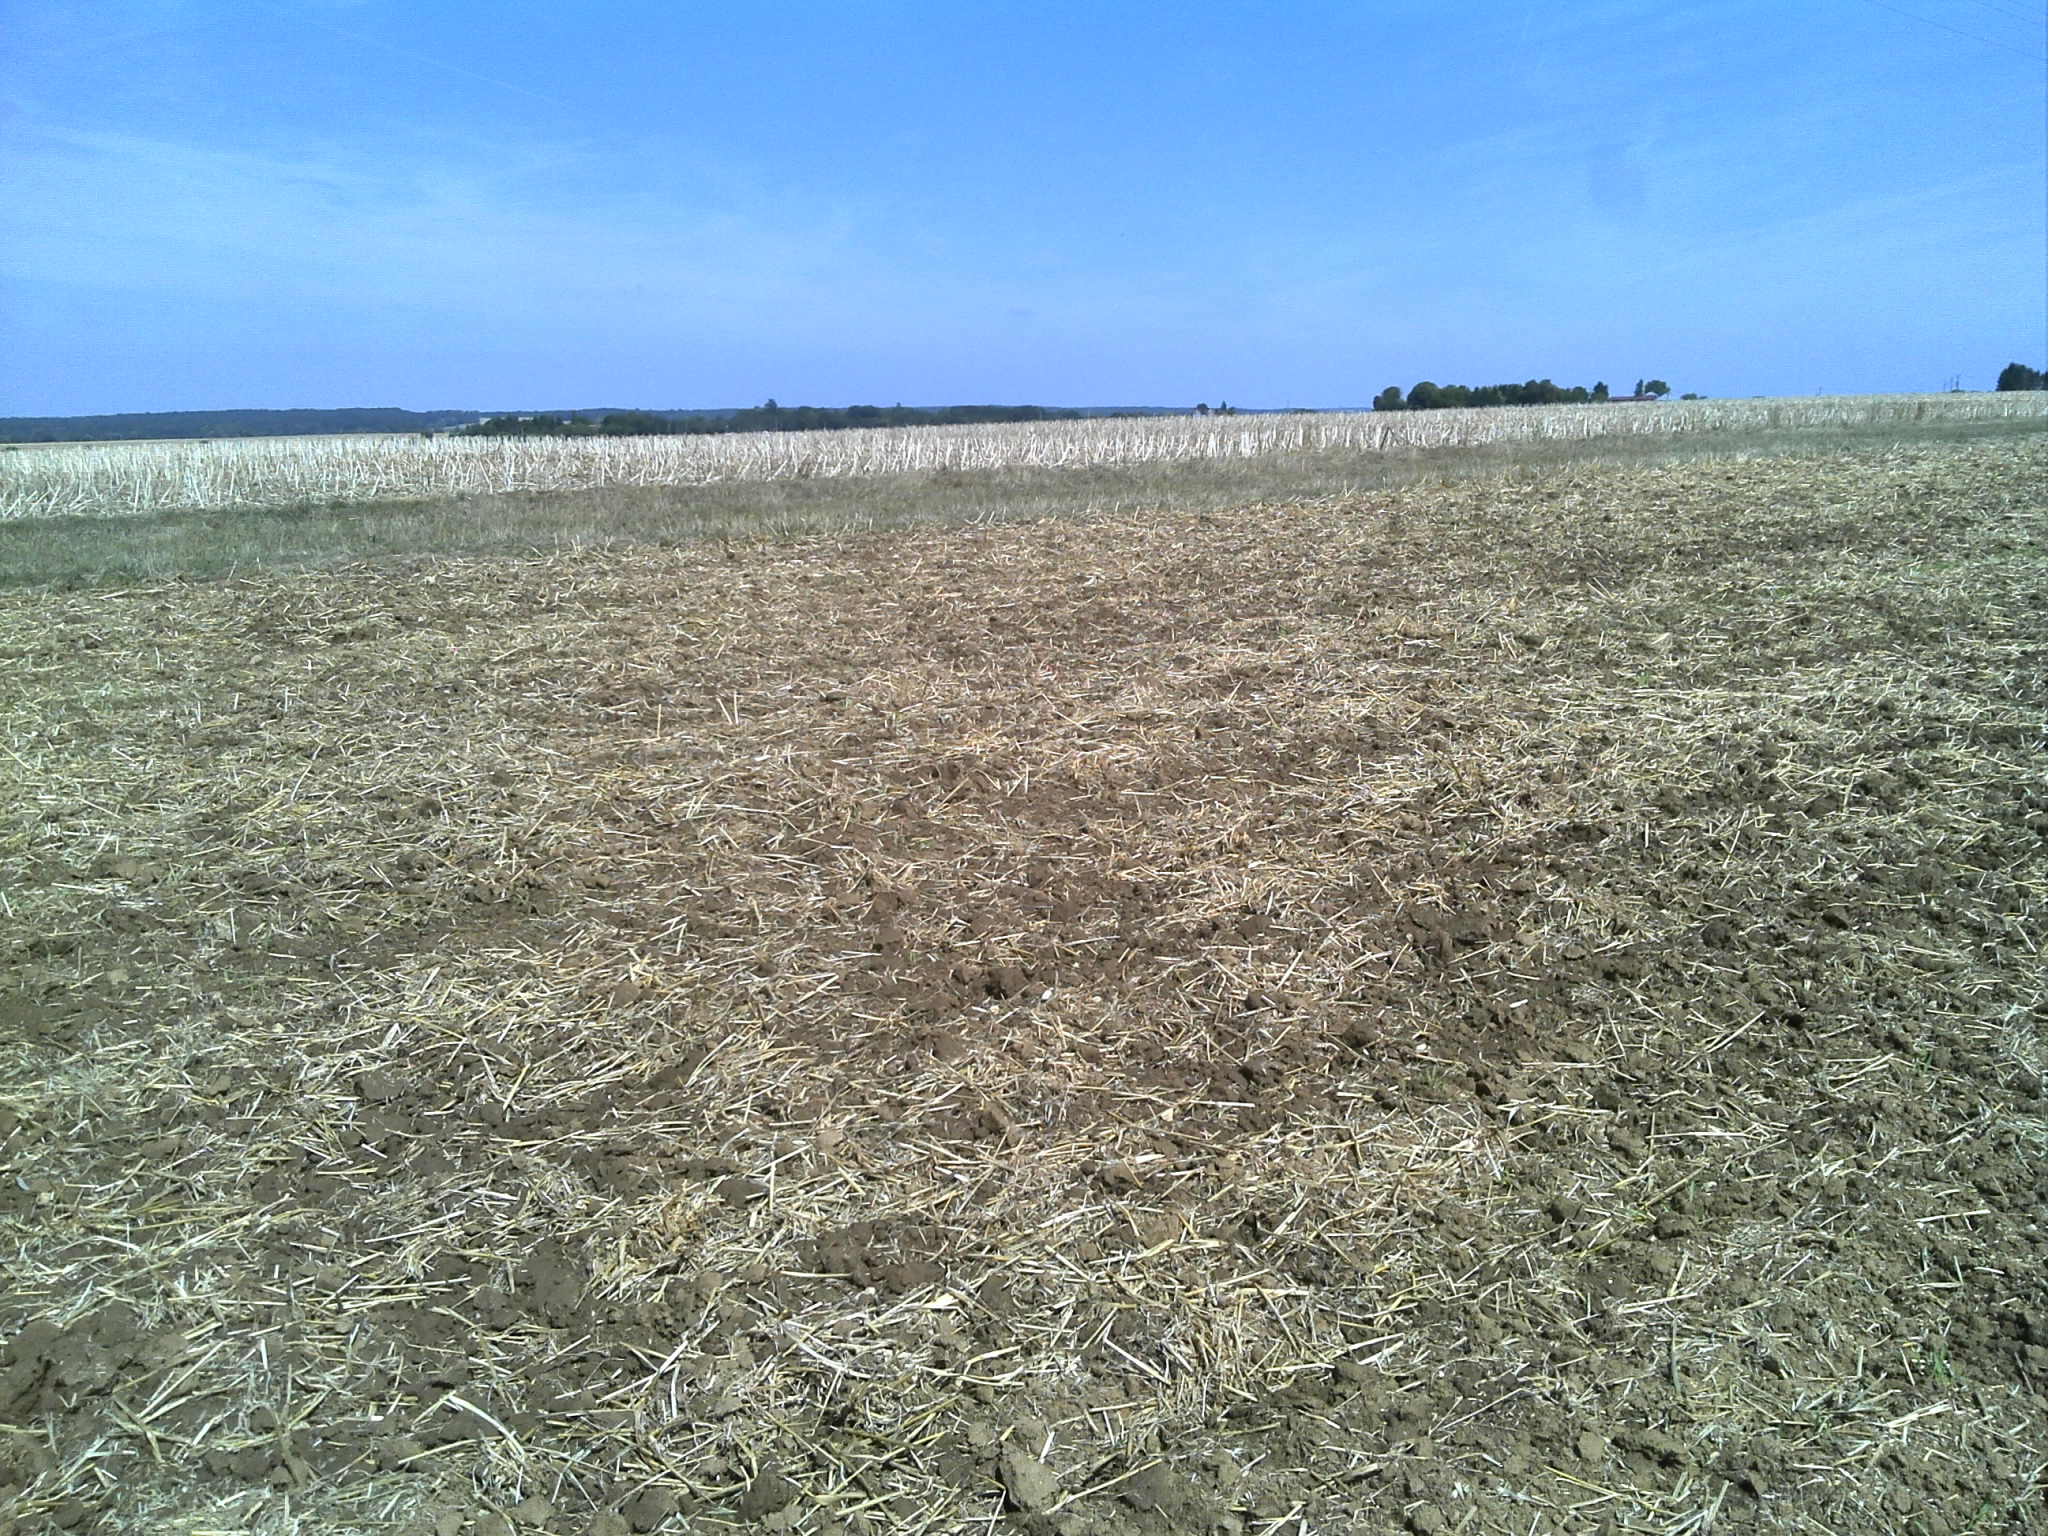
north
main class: Cropland
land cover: Barley
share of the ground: > 75 %
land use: Agriculture (excluding fallow land and kitchen gardens)
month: August
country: FR
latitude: 46.9548
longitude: 1.5128
